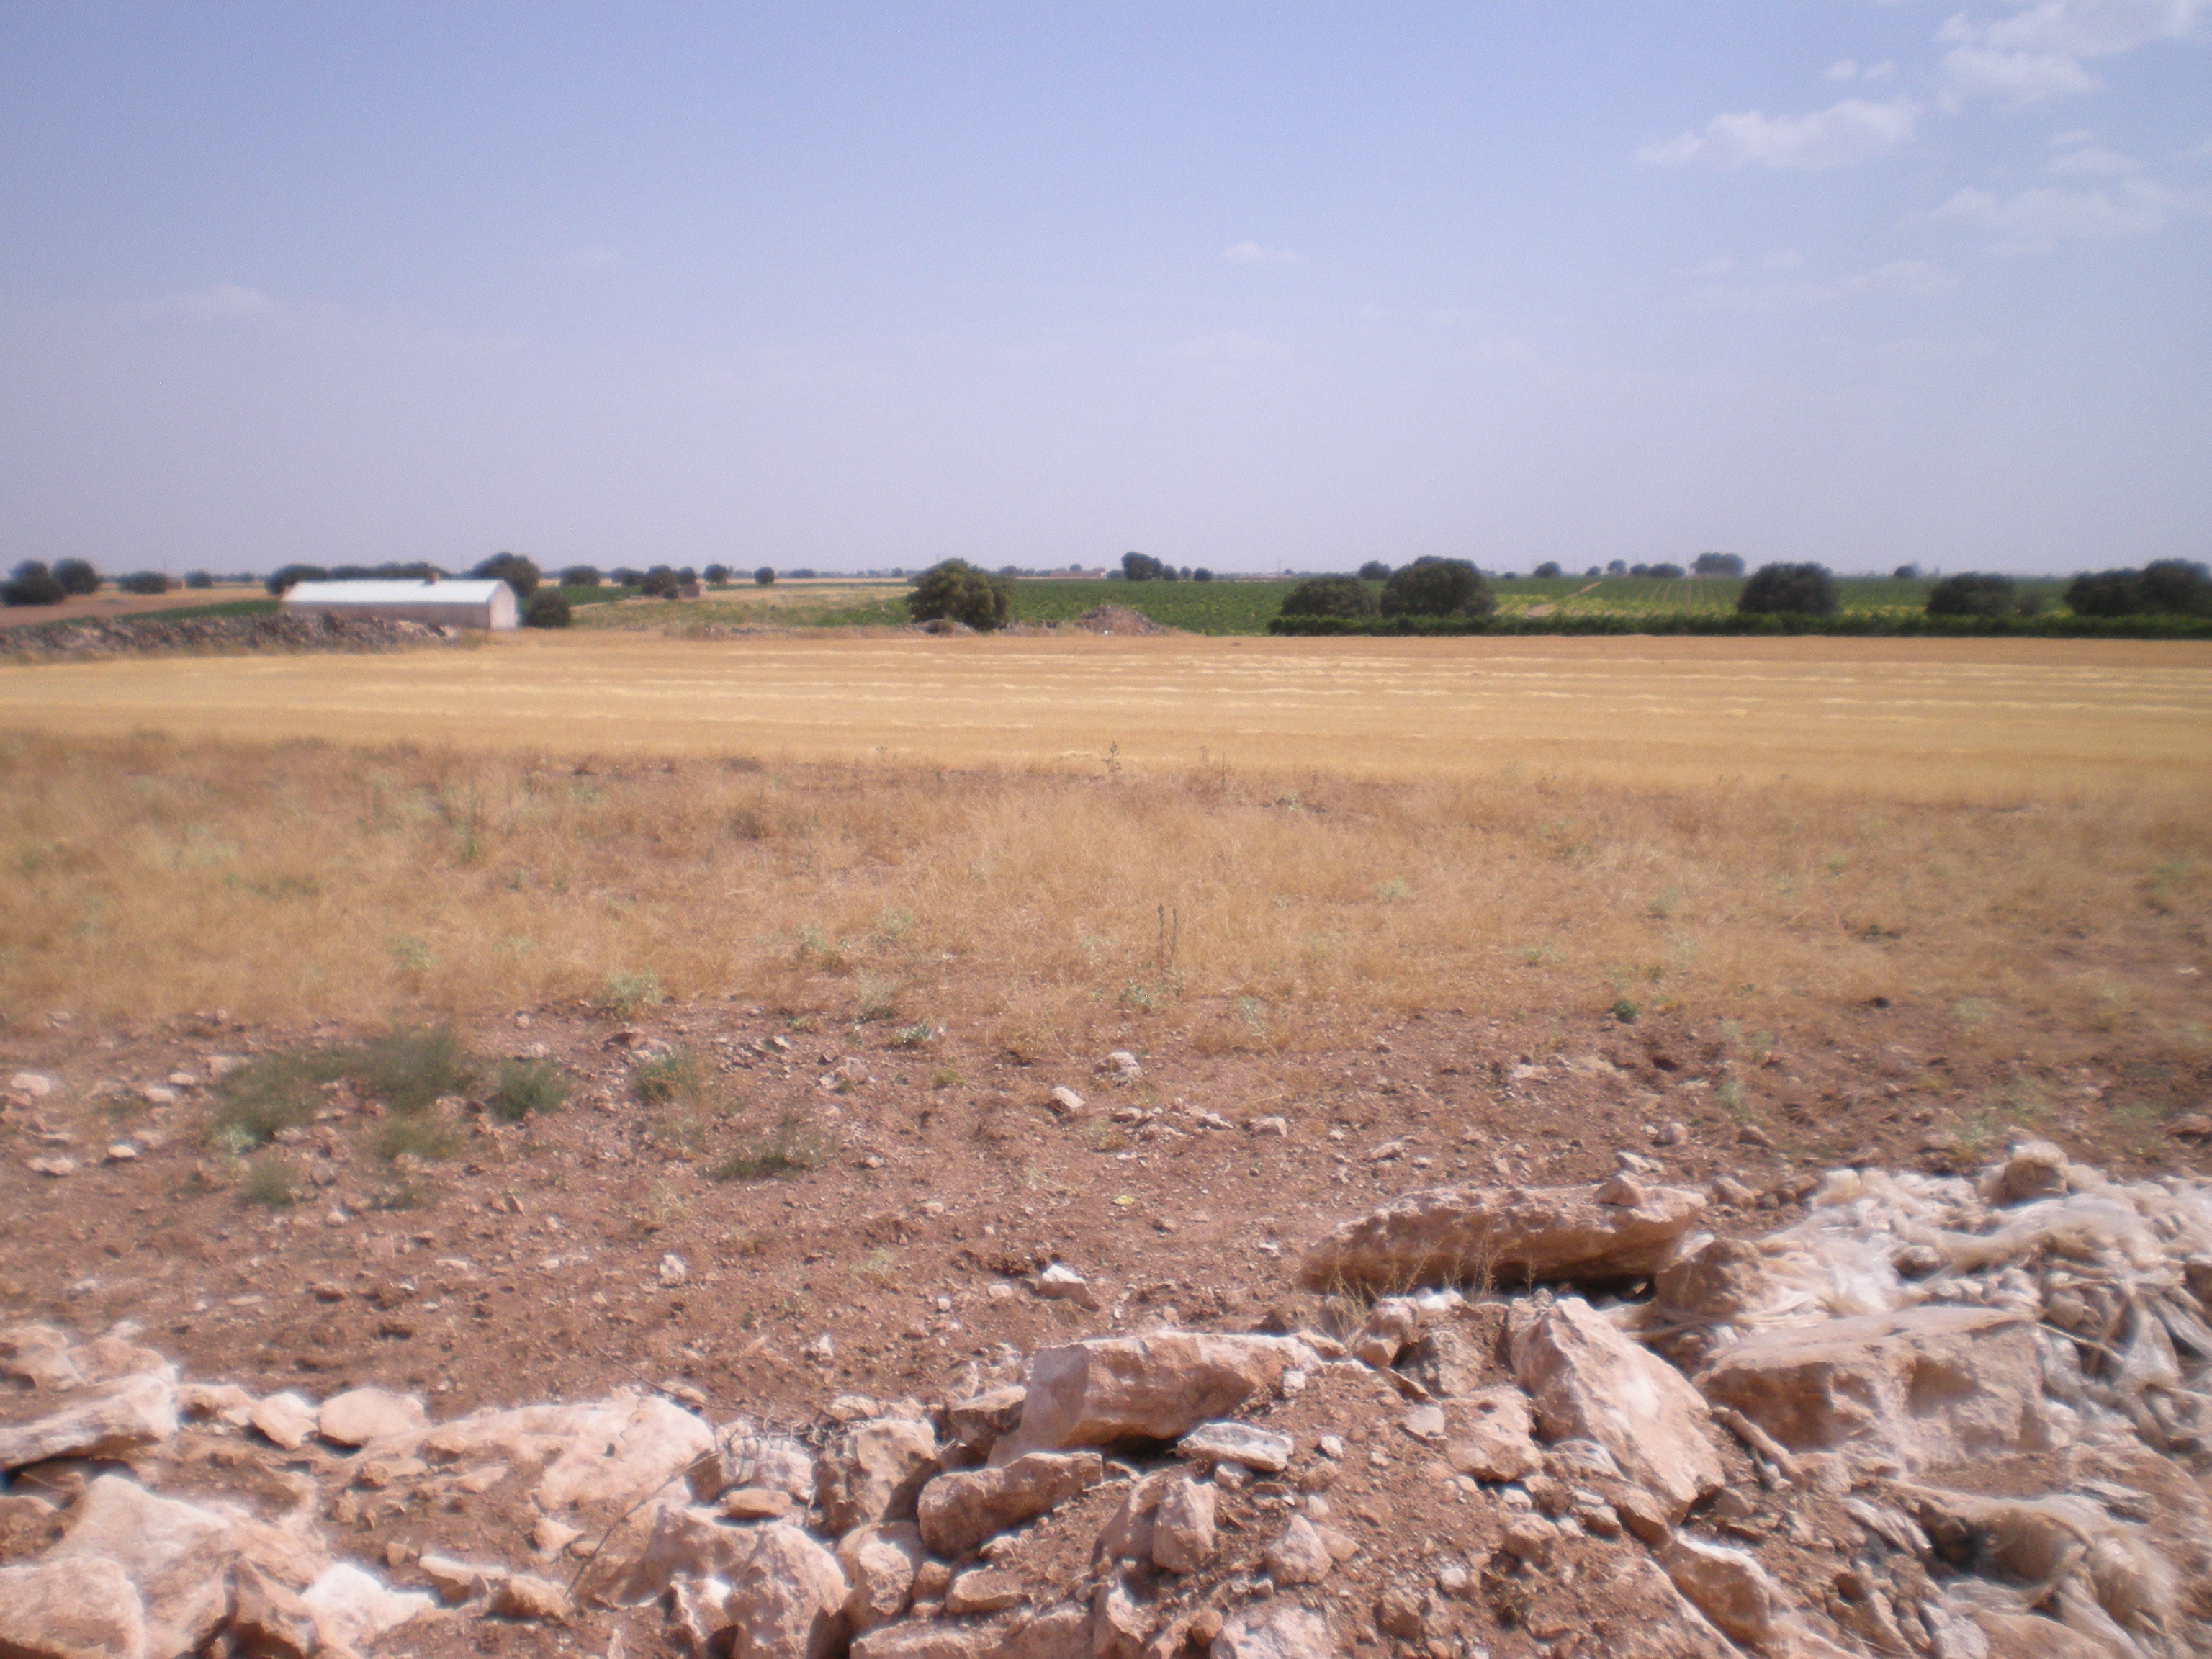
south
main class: Woodland
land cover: Broadleaved woodland
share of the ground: 25 - 50 %
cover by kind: unconsolidated bare surface 65 %, broadleaved forest trees 35 %
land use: Semi-natural and natural areas not in use
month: July
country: ES
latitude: 39.2559
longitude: -3.2389
